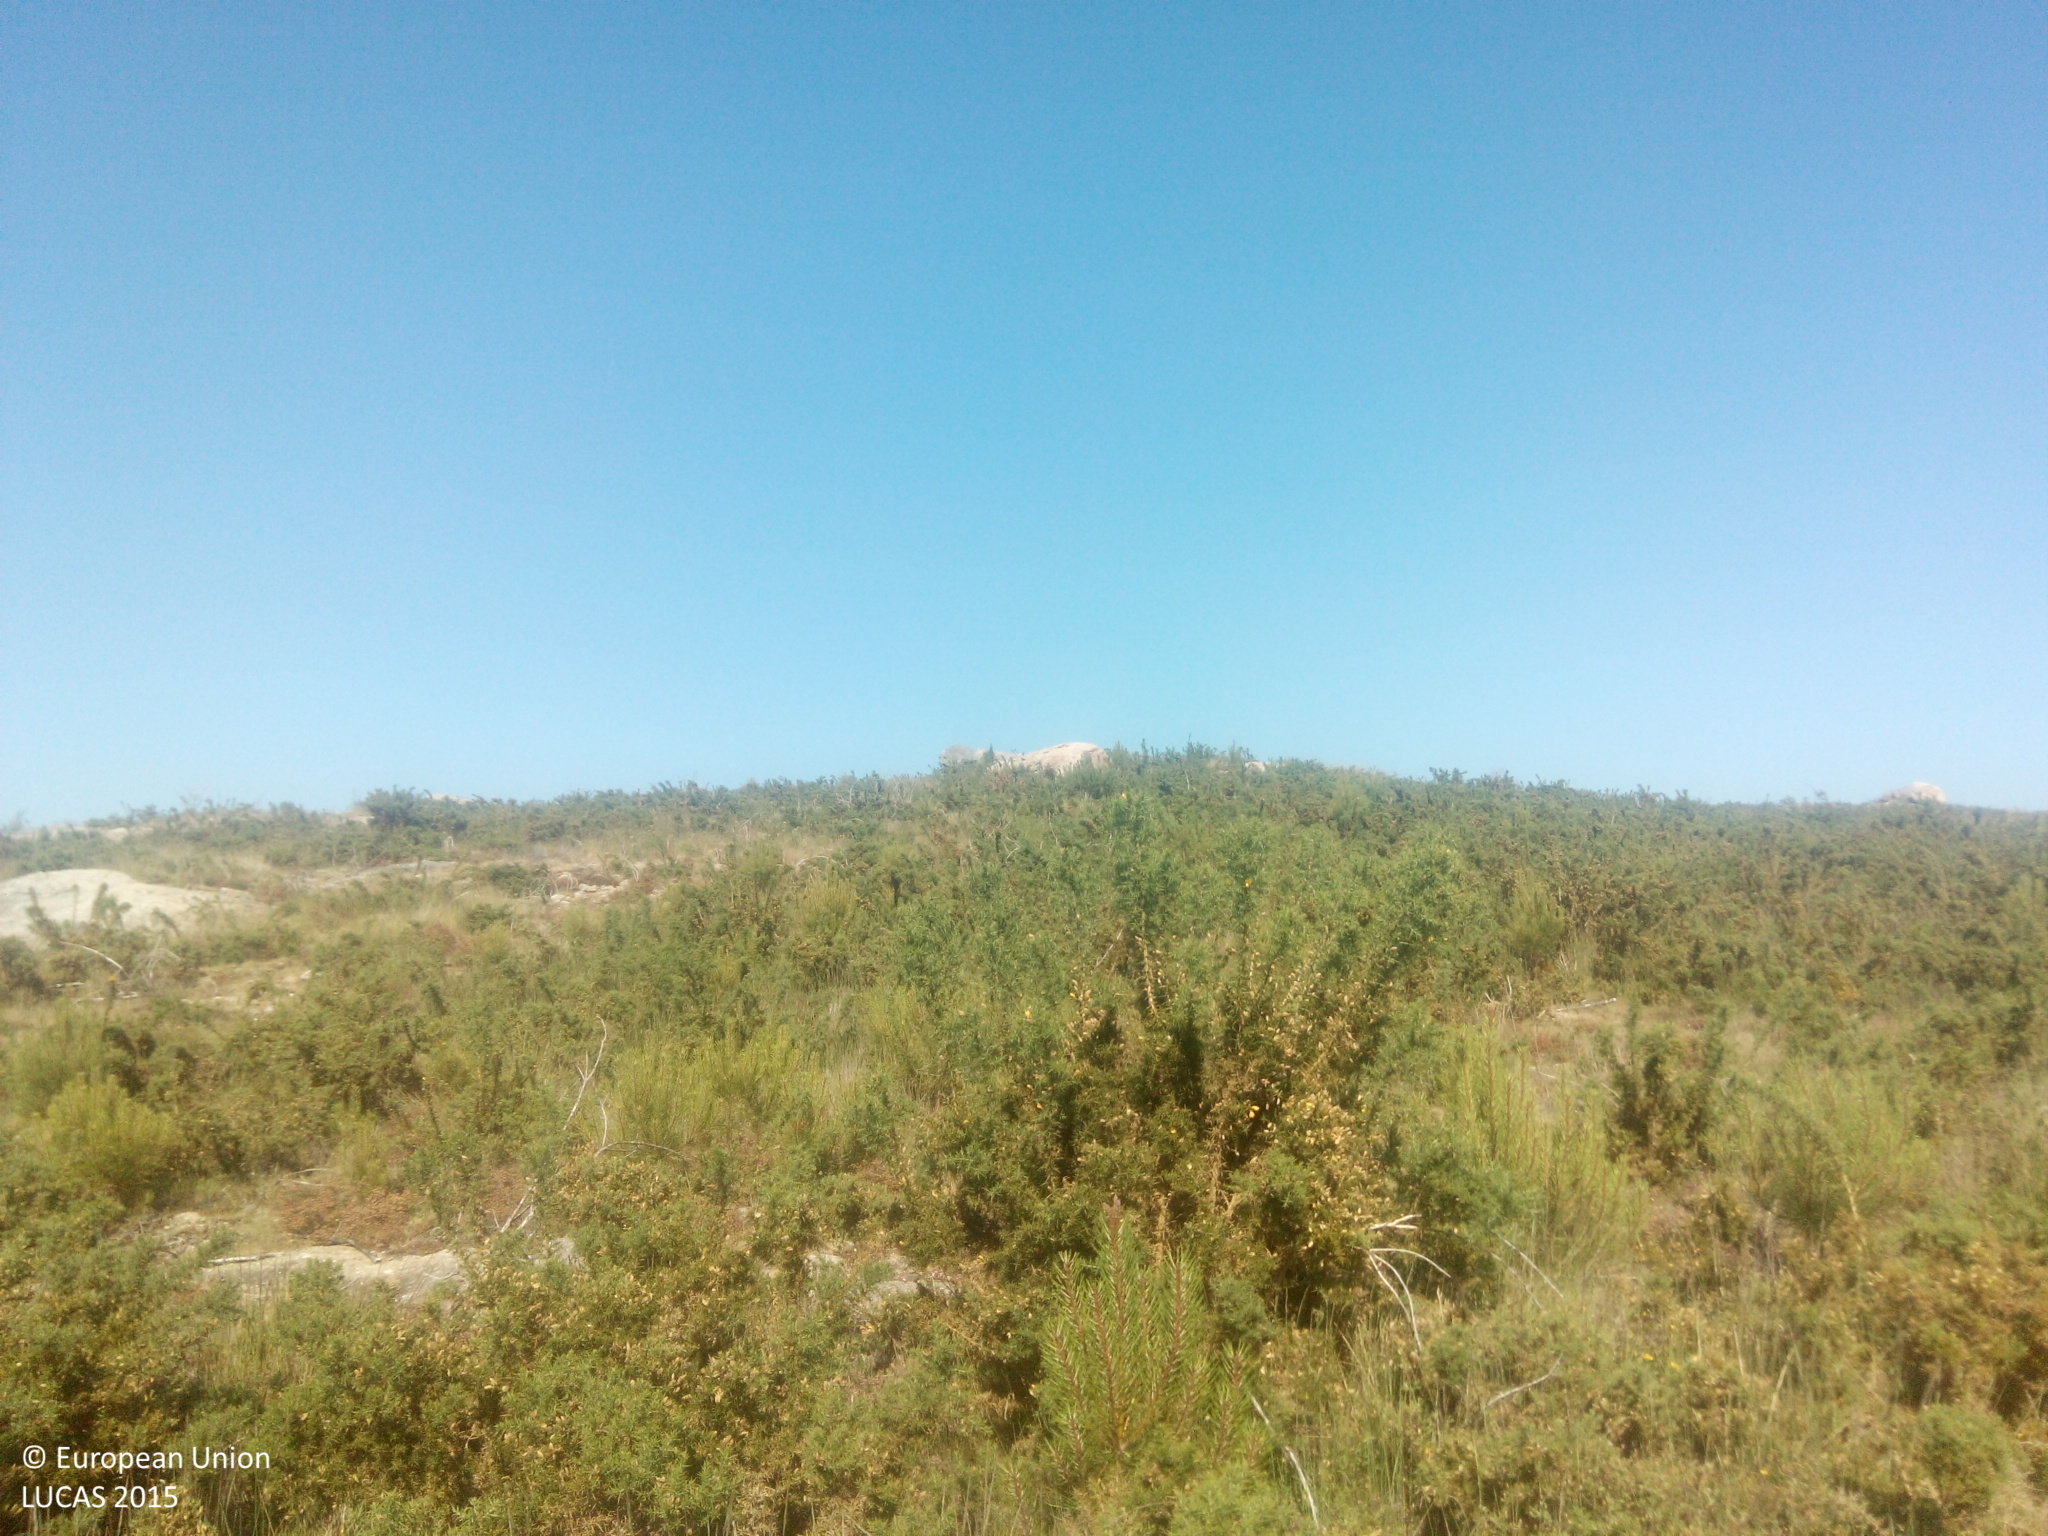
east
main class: Shrubland
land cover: Shrubland without tree cover
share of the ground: > 75 %
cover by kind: shrubs 100 %
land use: Semi-natural and natural areas not in use
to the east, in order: Shrubland without tree cover; Tracks; Shrubland with sparse tree cover; Rocks and stones; Shrubland with sparse tree cover; Tracks; Shrubland with sparse tree cover; Rocks and stones
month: June
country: ES
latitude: 42.1956
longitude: -8.2637
